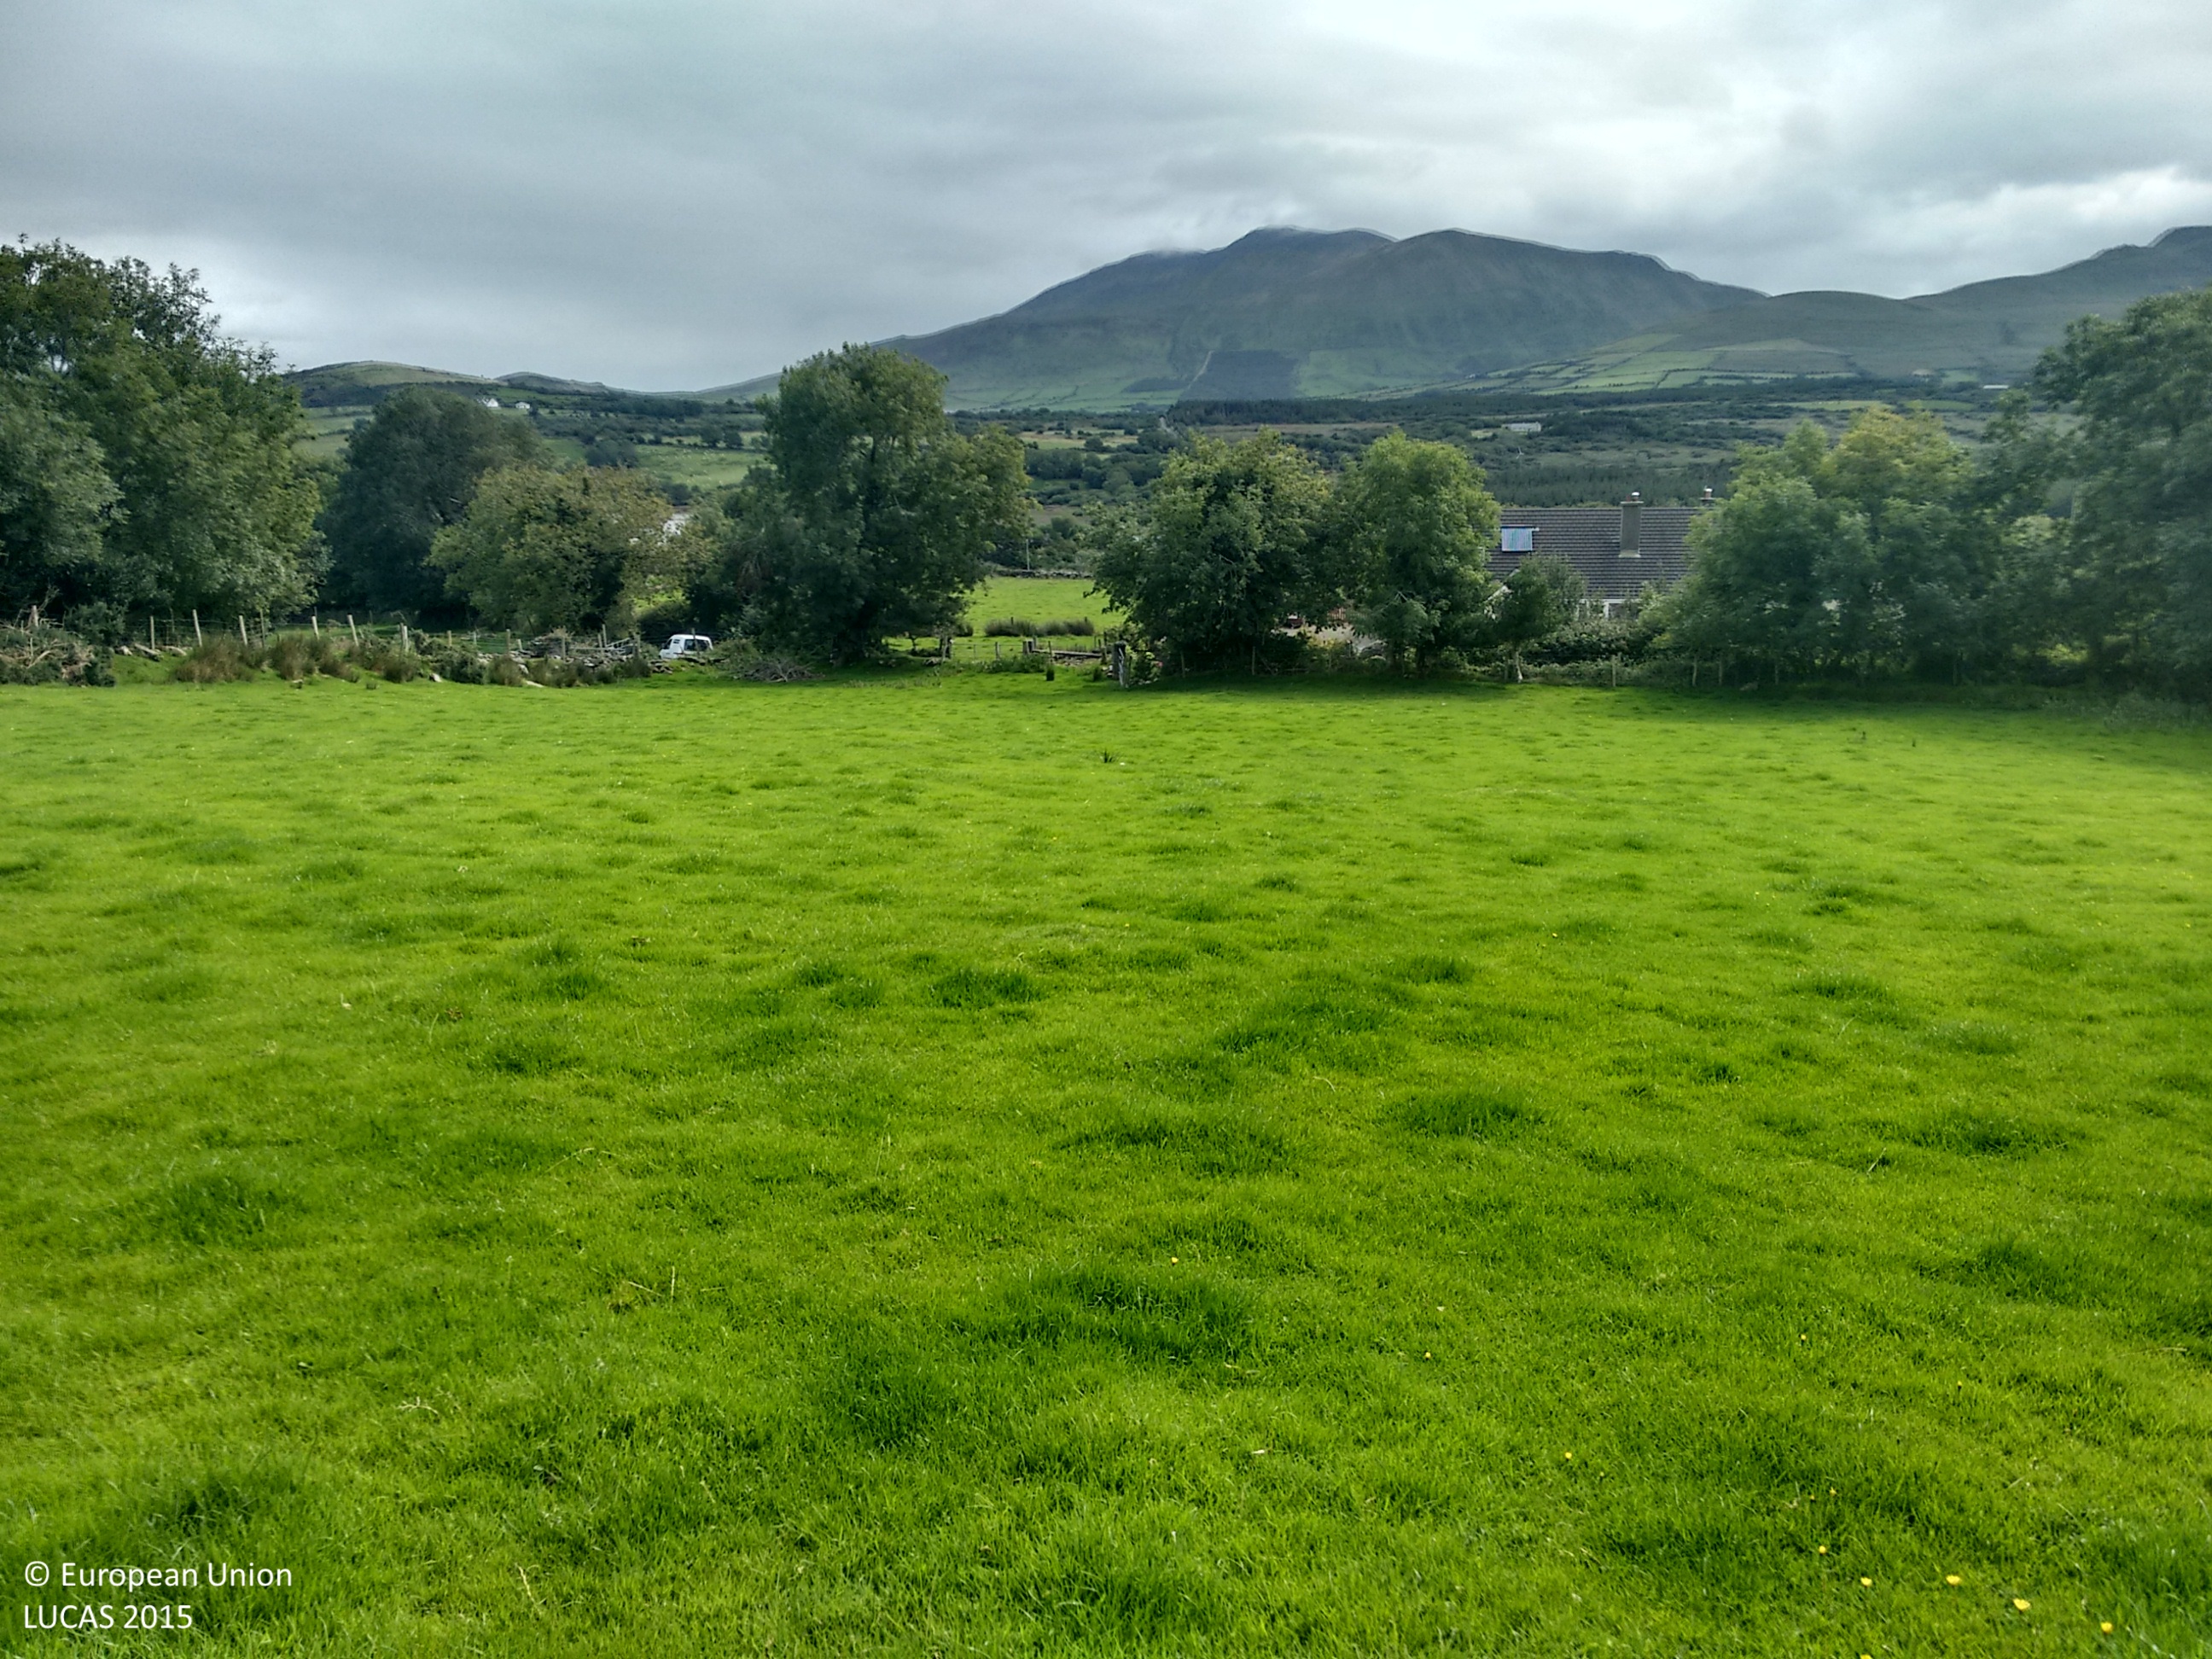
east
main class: Grassland
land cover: Grassland without tree/shrub cover
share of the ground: > 75 %
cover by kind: herbaceous plants 95 %, shrubs 5 %
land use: Agriculture (excluding fallow land and kitchen gardens)
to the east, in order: Grassland without tree/shrub cover; Fences; Single bushes/trees; Grass margins; Paved roads, cycling and walking lanes; Lines of trees; Fences; Grassland without tree/shrub cover; Dry stone walls; Grassland without tree/shrub cover; Single bushes/trees; Dry stone walls; Grassland without tree/shrub cover; Artificial constructions in urban areas; Grassland without tree/shrub cover
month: September
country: IE
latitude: 52.2308
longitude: -10.1893
